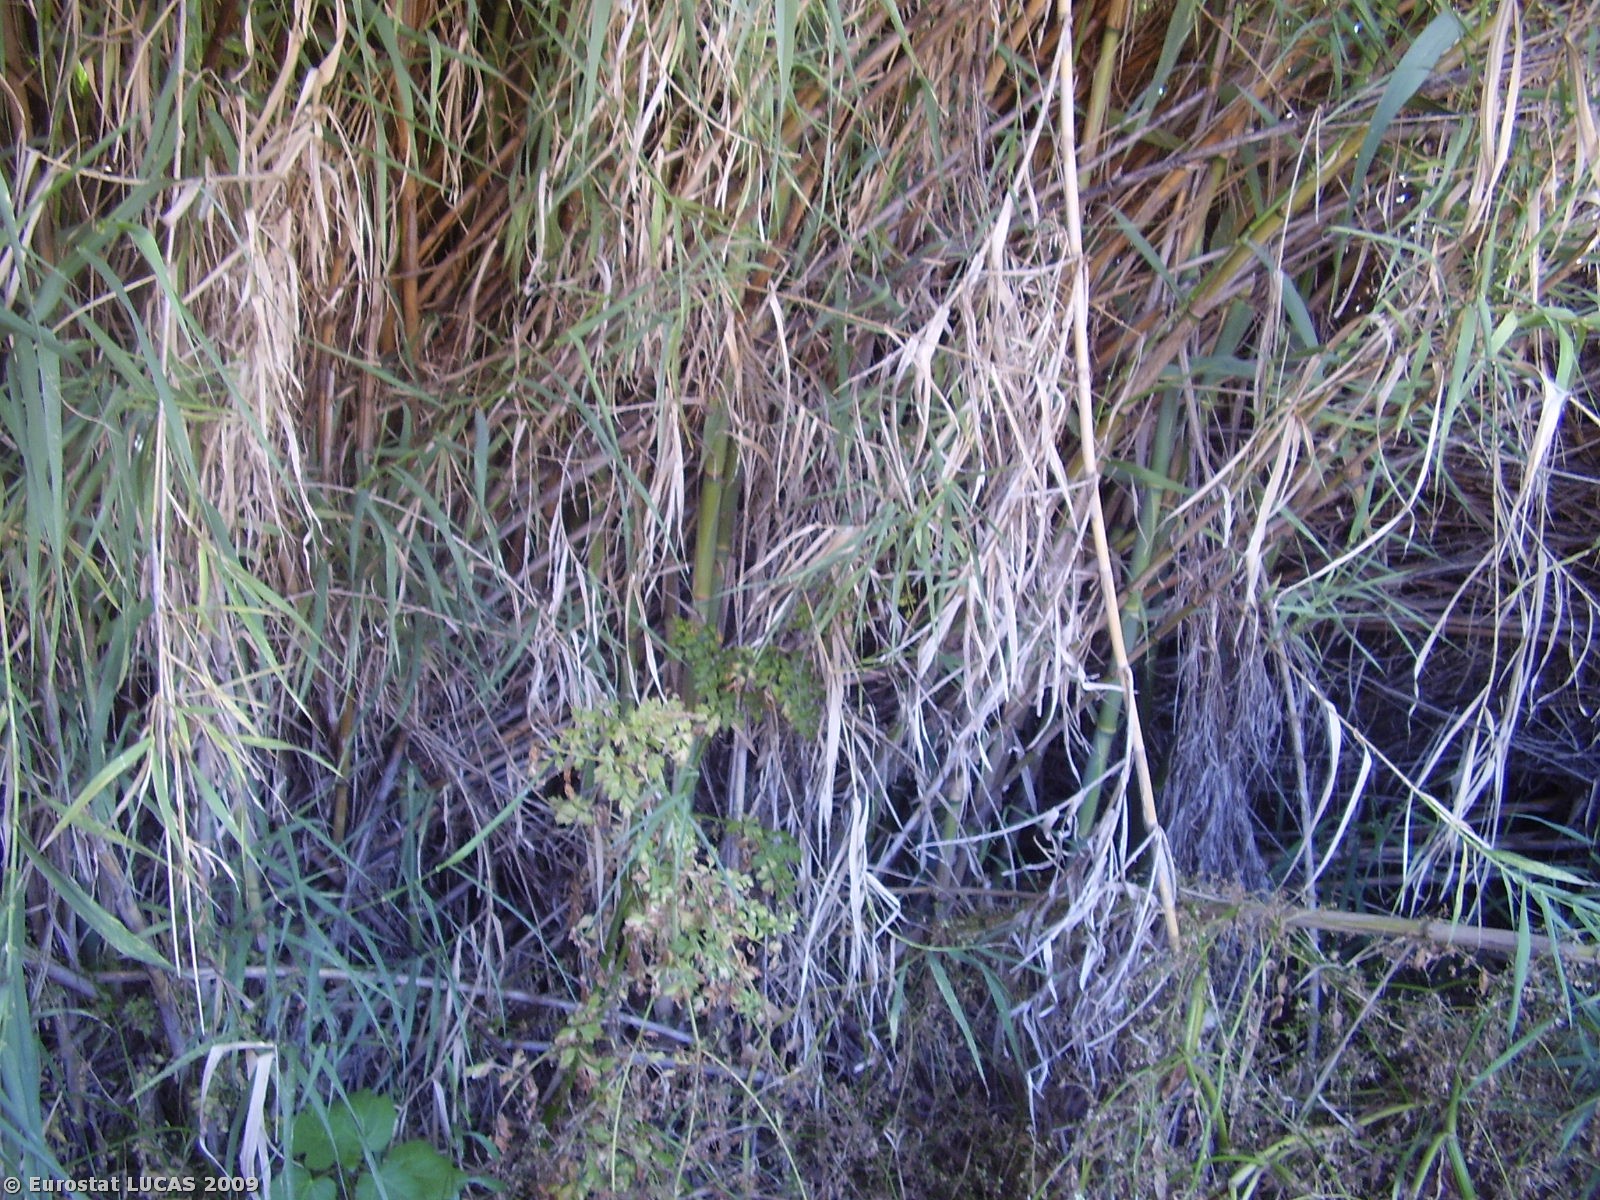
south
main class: Wetlands
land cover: Inland marshes
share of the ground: > 75 %
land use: Unused
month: July
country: PT
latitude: 38.0178
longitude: -7.7840
